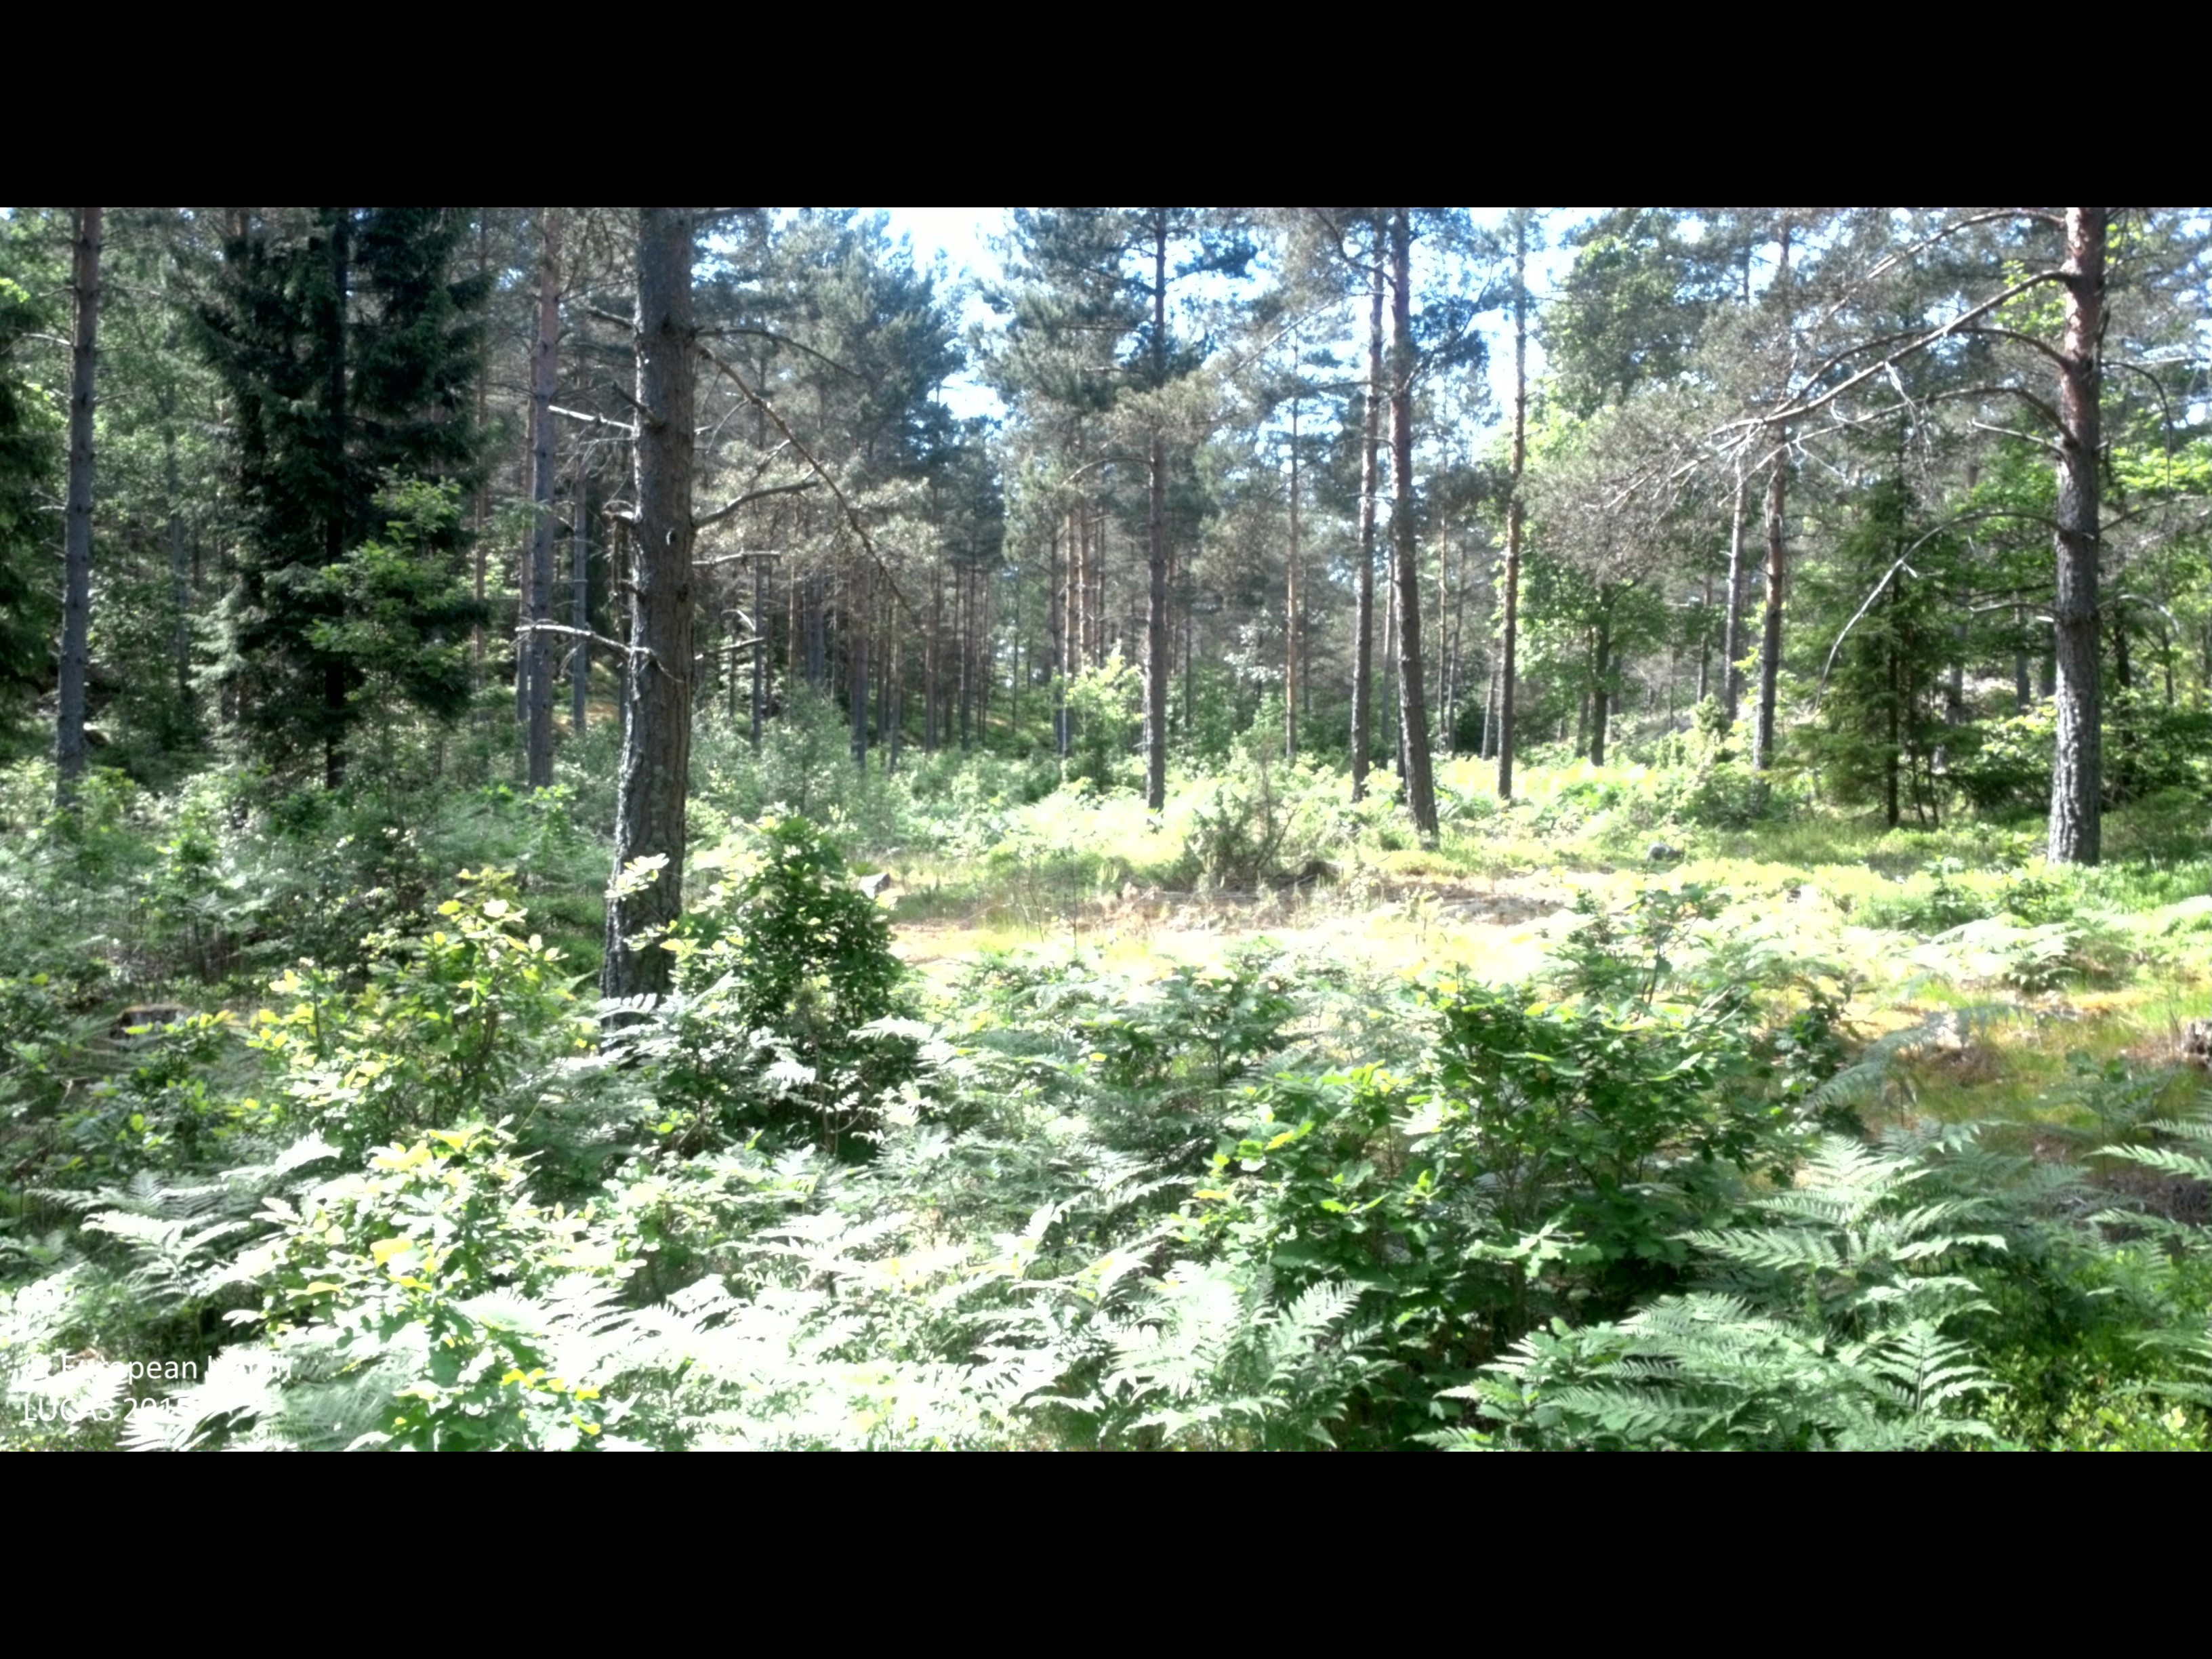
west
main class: Woodland
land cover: Pine dominated mixed woodland
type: boreal forest
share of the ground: 50 - 75 %
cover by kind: coniferous forest trees 45 %, broadleaved forest trees 20 %, herbaceous plants 15 %, shrubs 10 %, lichens and mosses 10 %
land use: Forestry
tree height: > 5 m
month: June
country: SE
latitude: 57.6072
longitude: 16.5765
